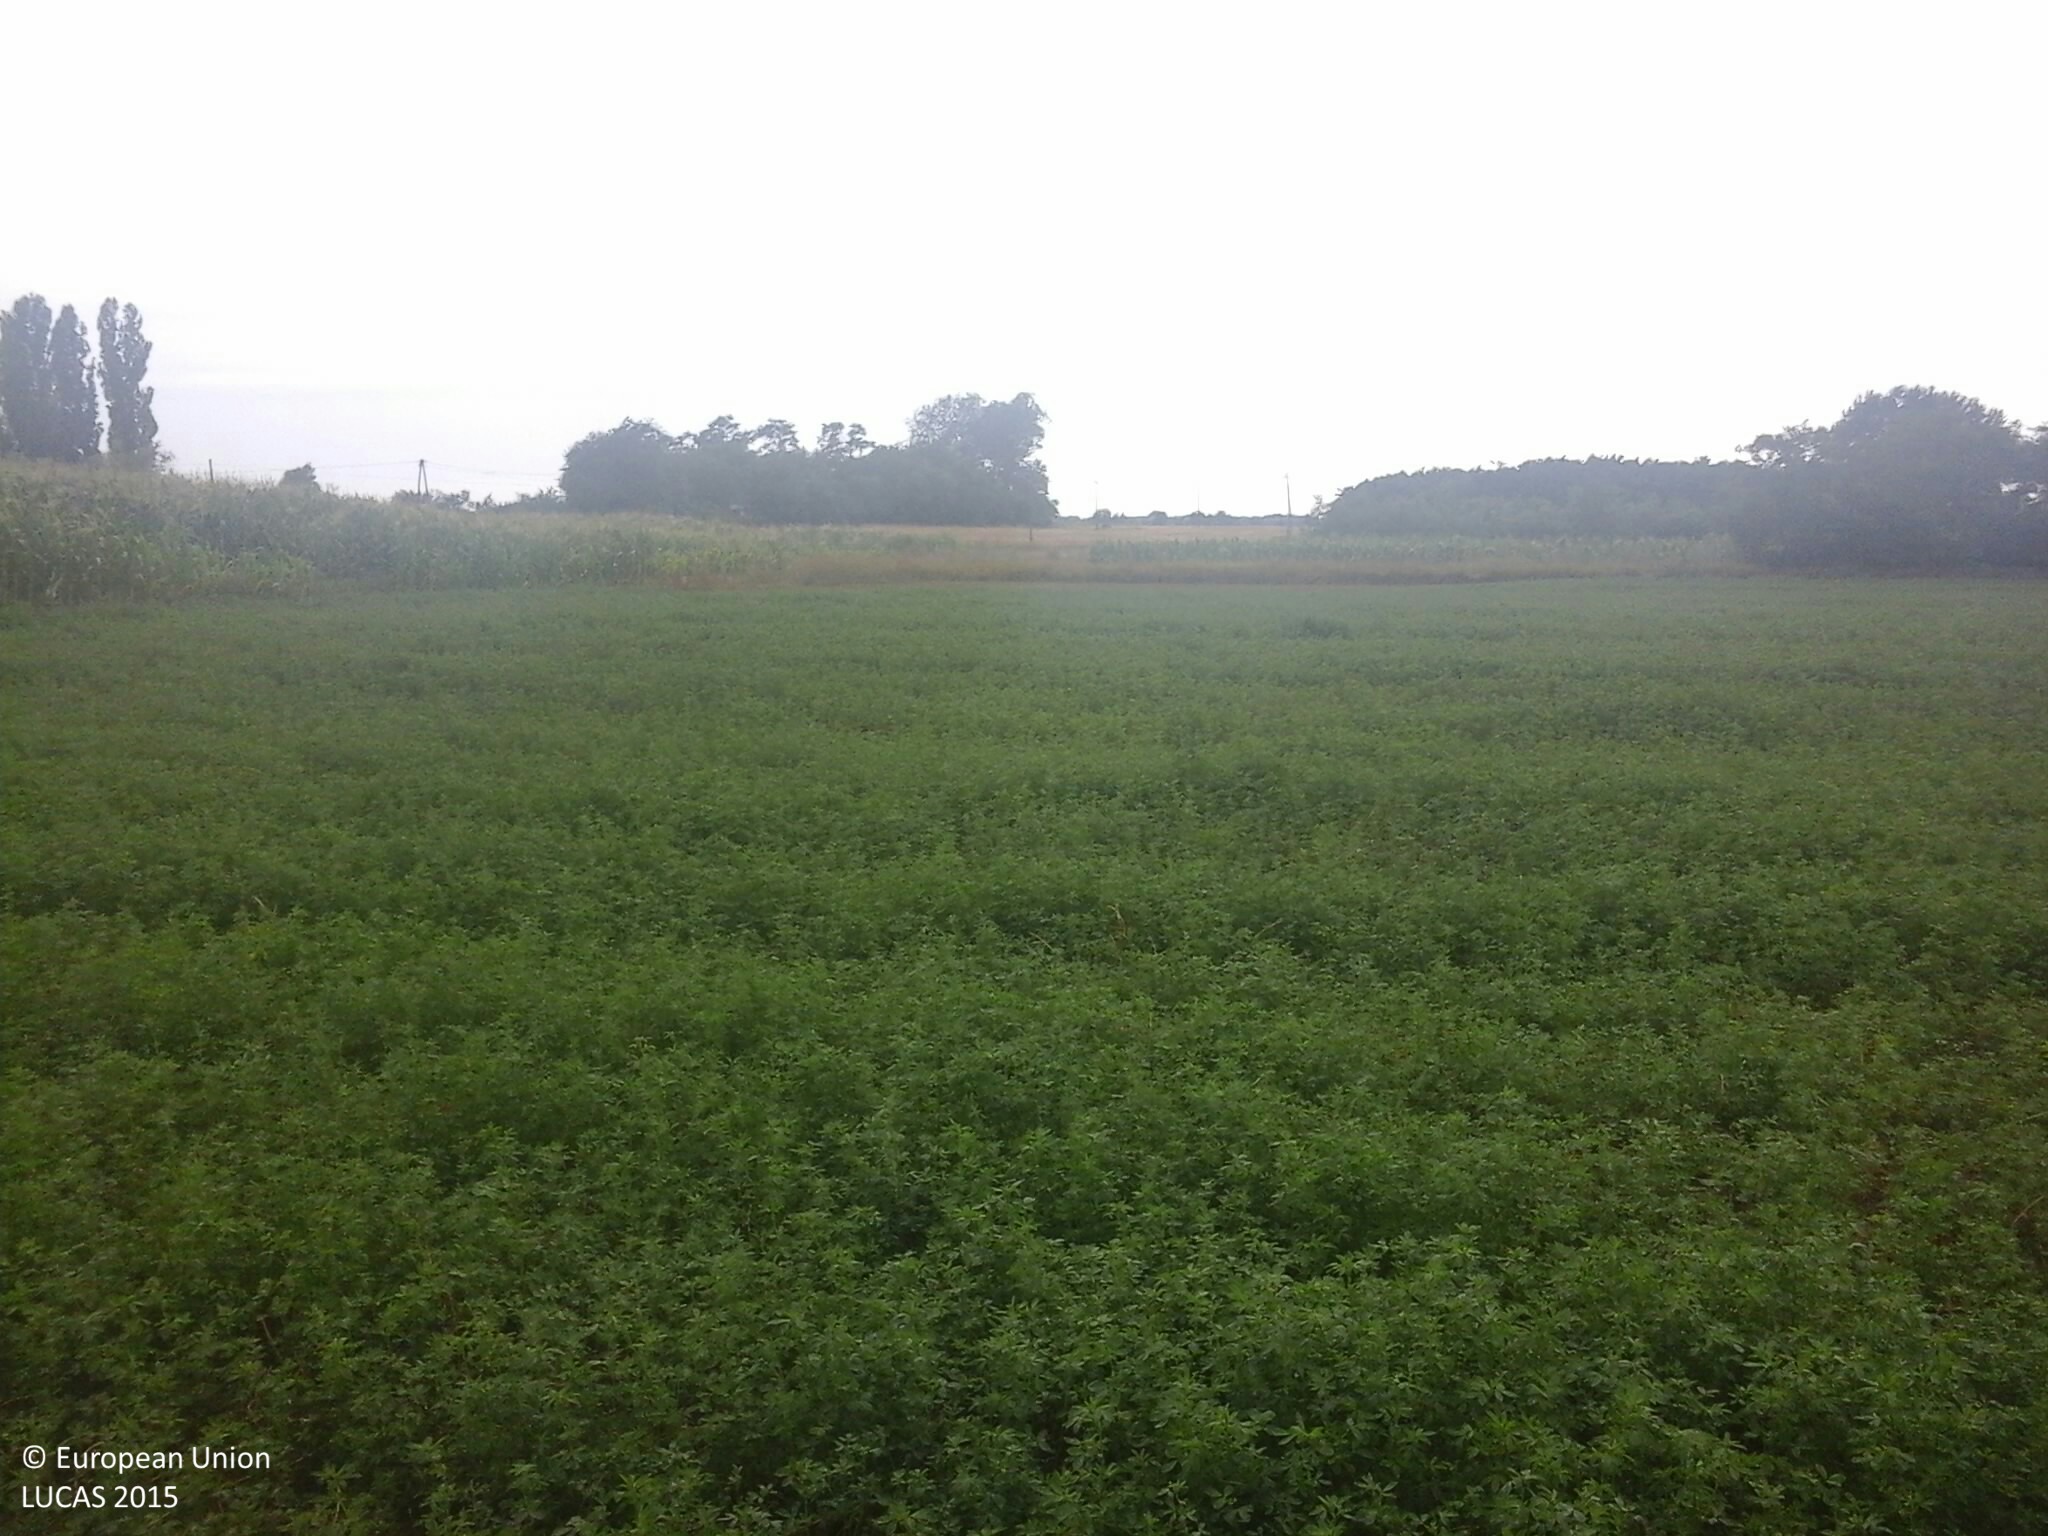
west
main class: Cropland
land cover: Lucerne
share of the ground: > 75 %
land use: Agriculture (excluding fallow land and kitchen gardens)
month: July
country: HU
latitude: 46.6831
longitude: 20.1565
